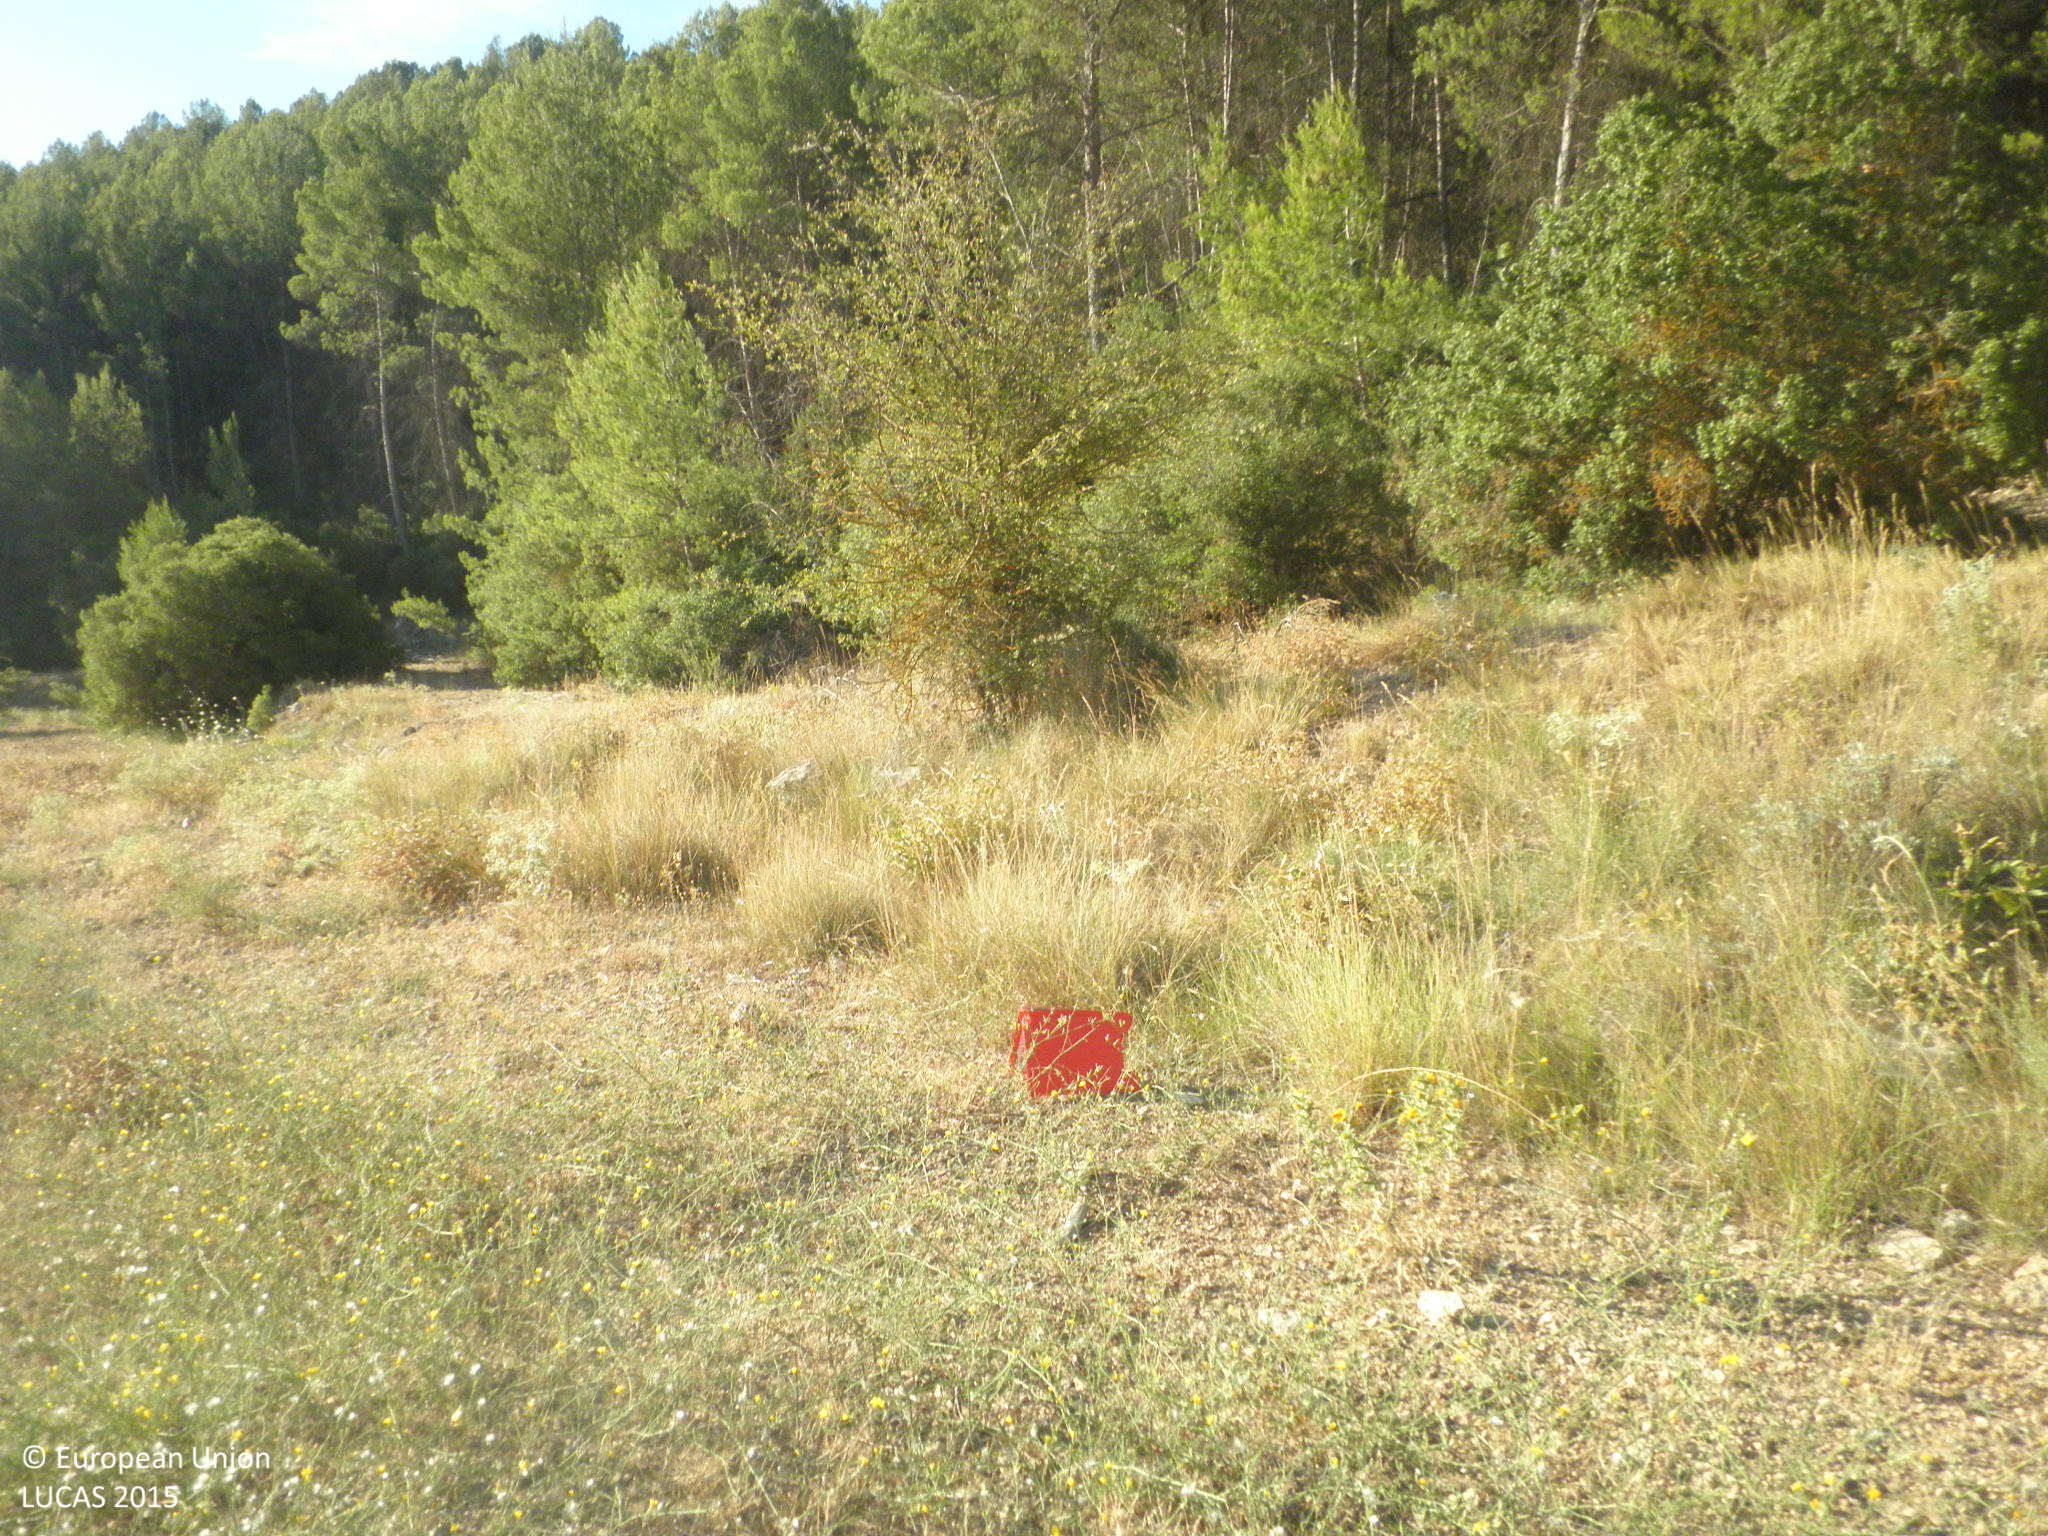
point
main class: Grassland
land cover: Grassland with sparse tree/shrub cover
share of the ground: > 75 %
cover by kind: herbaceous plants 75 %, unconsolidated bare surface 15 %, coniferous forest trees 5 %, shrubs 5 %
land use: Semi-natural and natural areas not in use
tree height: > 5 m
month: July
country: ES
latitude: 39.4680
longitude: -1.5930
